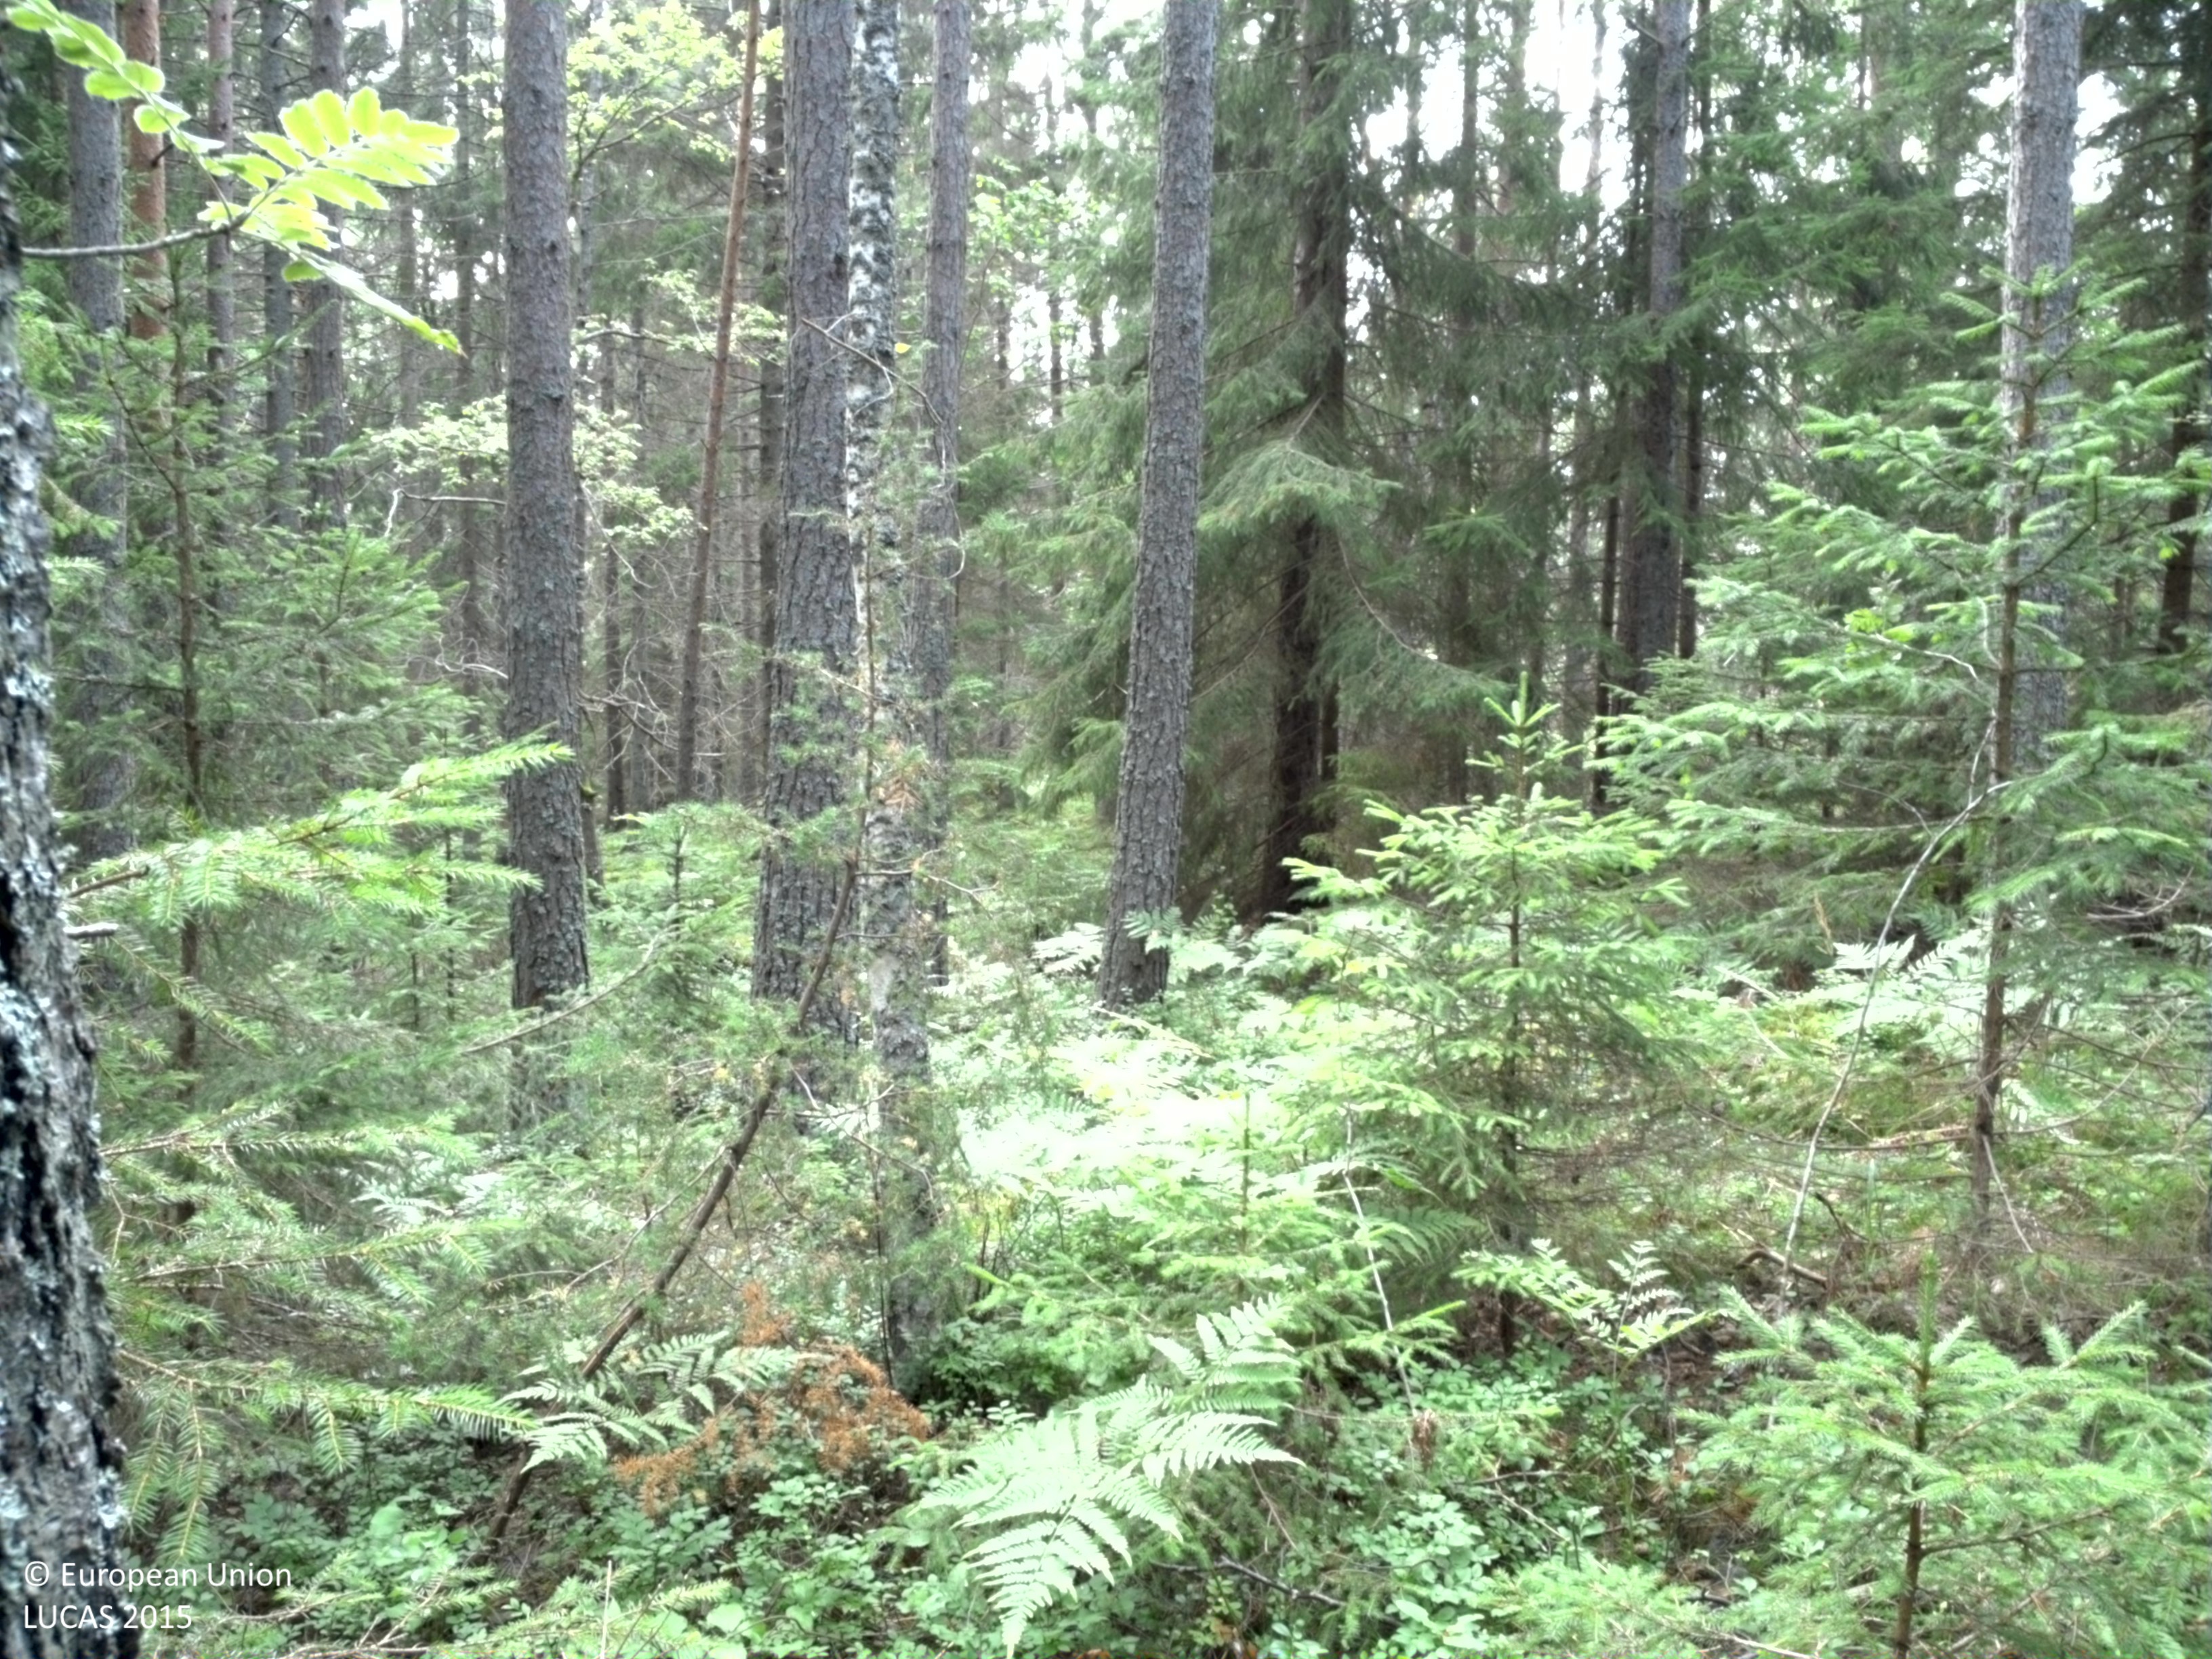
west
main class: Woodland
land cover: Spruce dominated coniferous woodland
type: boreal forest
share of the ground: > 75 %
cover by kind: coniferous forest trees 75 %, shrubs 10 %, lichens and mosses 10 %, broadleaved forest trees 5 %
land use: Forestry
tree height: > 5 m
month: July
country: SE
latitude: 59.4852
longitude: 18.5640
